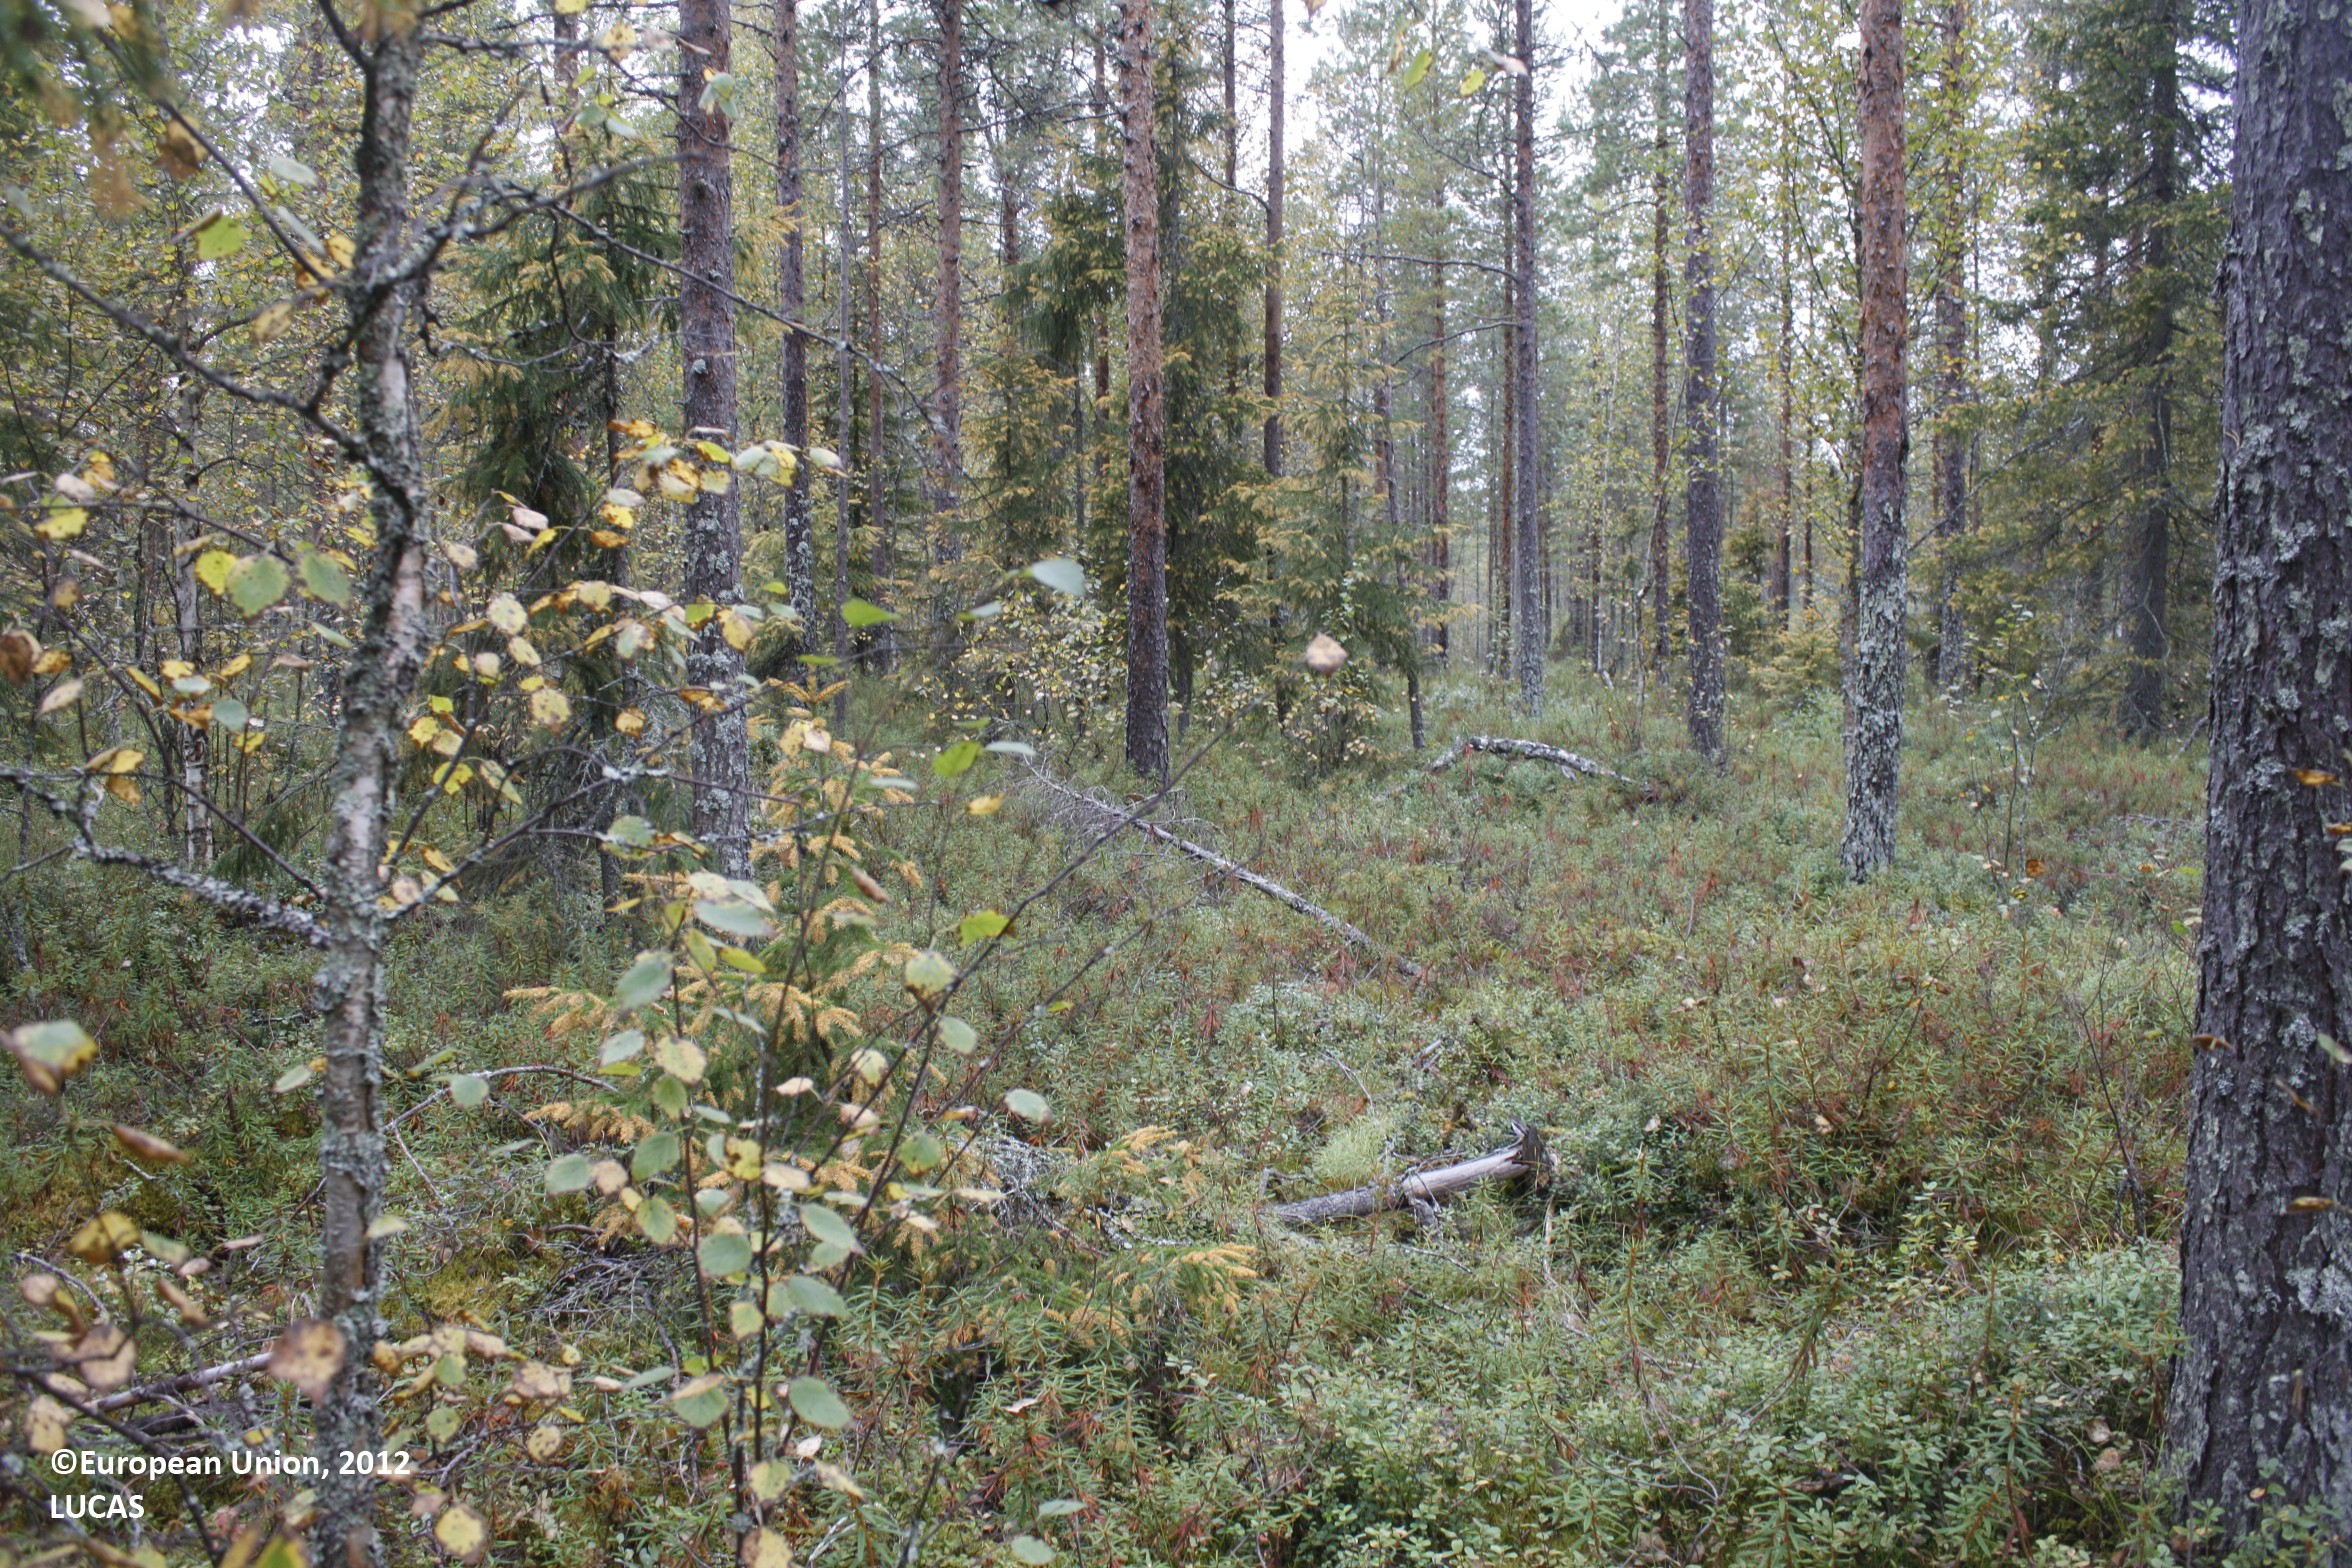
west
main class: Woodland
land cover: Pine dominated mixed woodland
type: boreal forest
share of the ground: 25 - 50 %
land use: Forestry
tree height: > 5 m
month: September
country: FI
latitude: 65.1269
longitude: 26.7984
